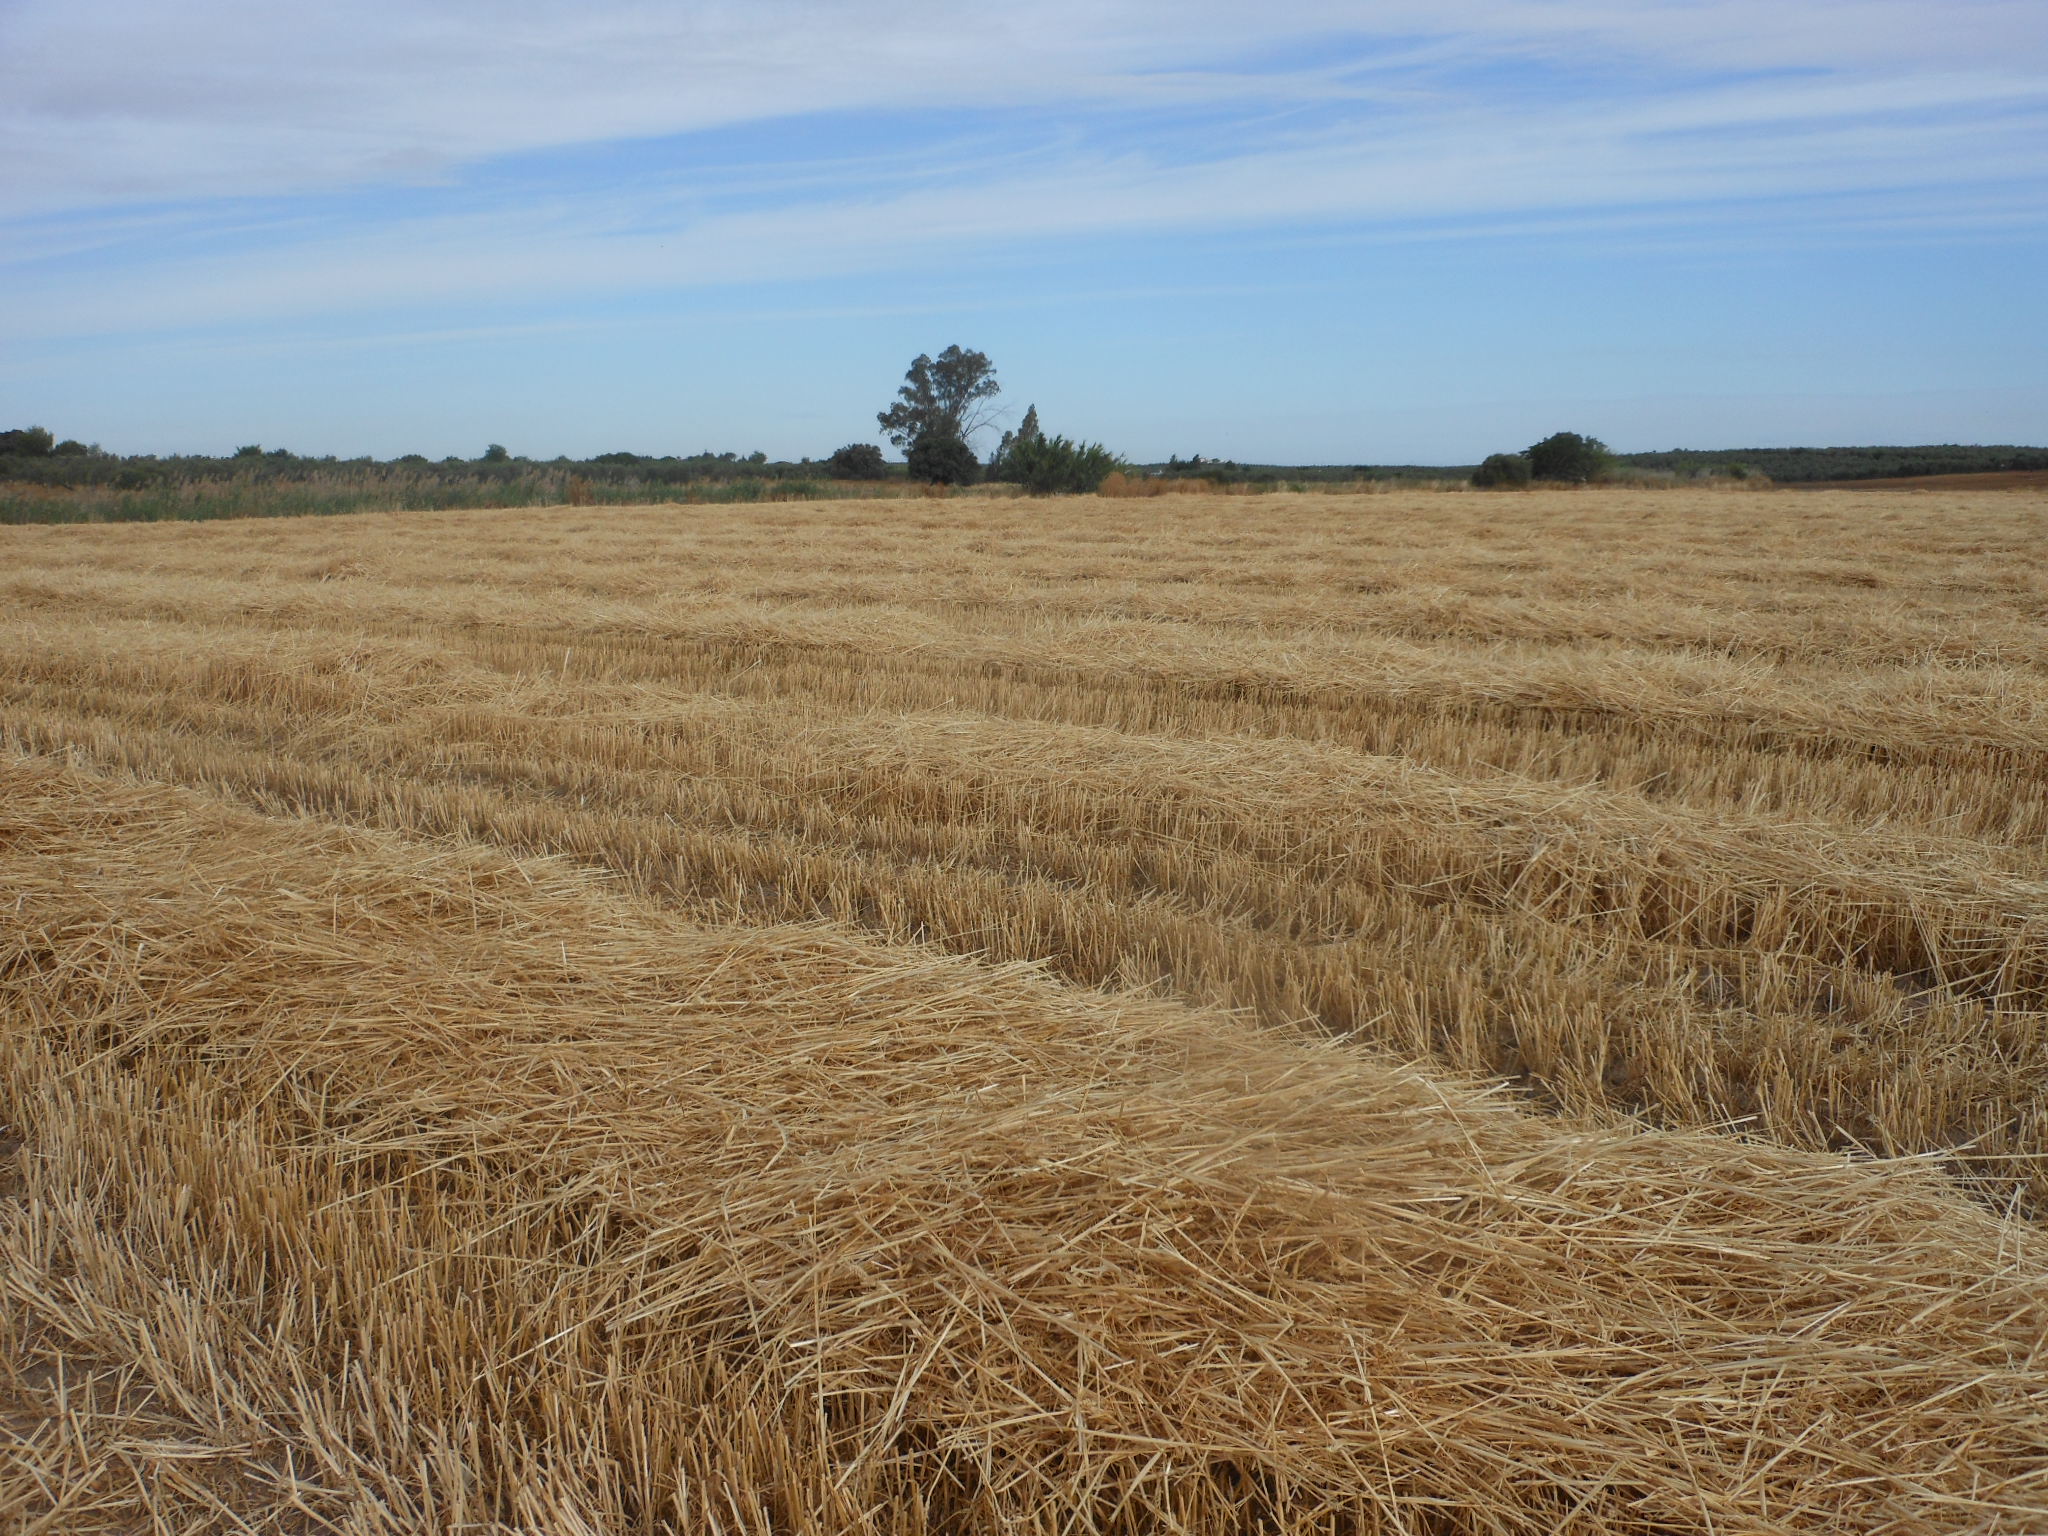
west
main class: Cropland
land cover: Common wheat
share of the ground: < 10 %
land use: Agriculture (excluding fallow land and kitchen gardens)
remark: Harvested field
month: June
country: ES
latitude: 37.1939
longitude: -5.4570
